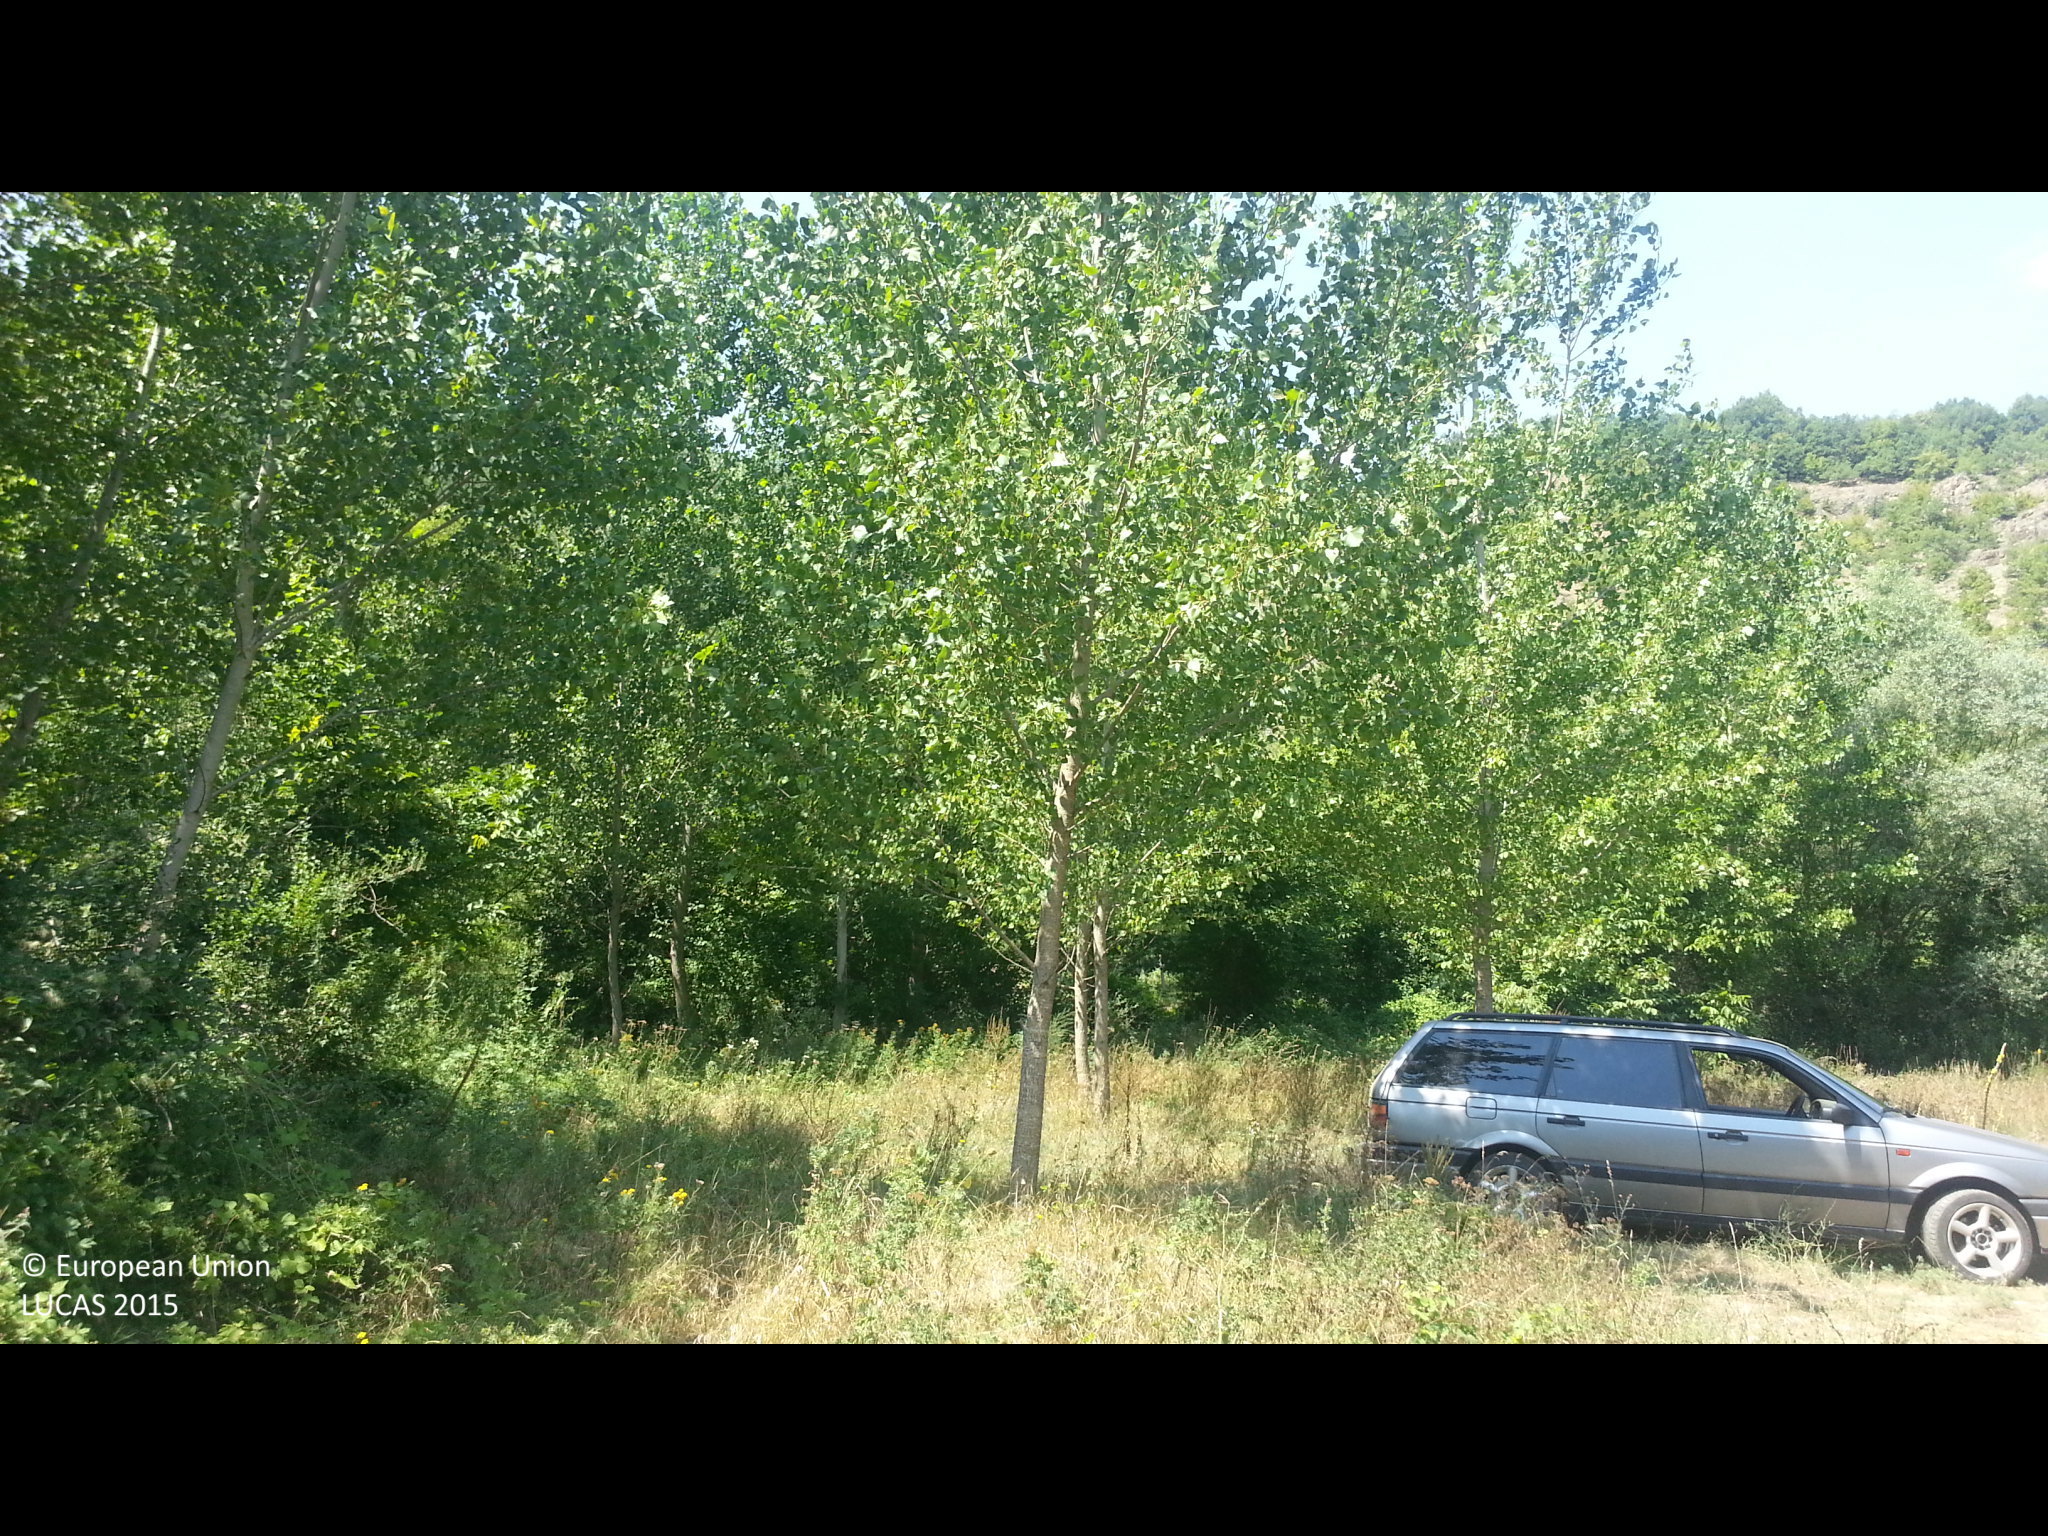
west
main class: Grassland
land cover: Grassland with sparse tree/shrub cover
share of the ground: > 75 %
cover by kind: herbaceous plants 90 %, broadleaved forest trees 5 %, shrubs 5 %
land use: Residential
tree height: > 5 m
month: August
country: BG
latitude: 42.2090
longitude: 22.8992
